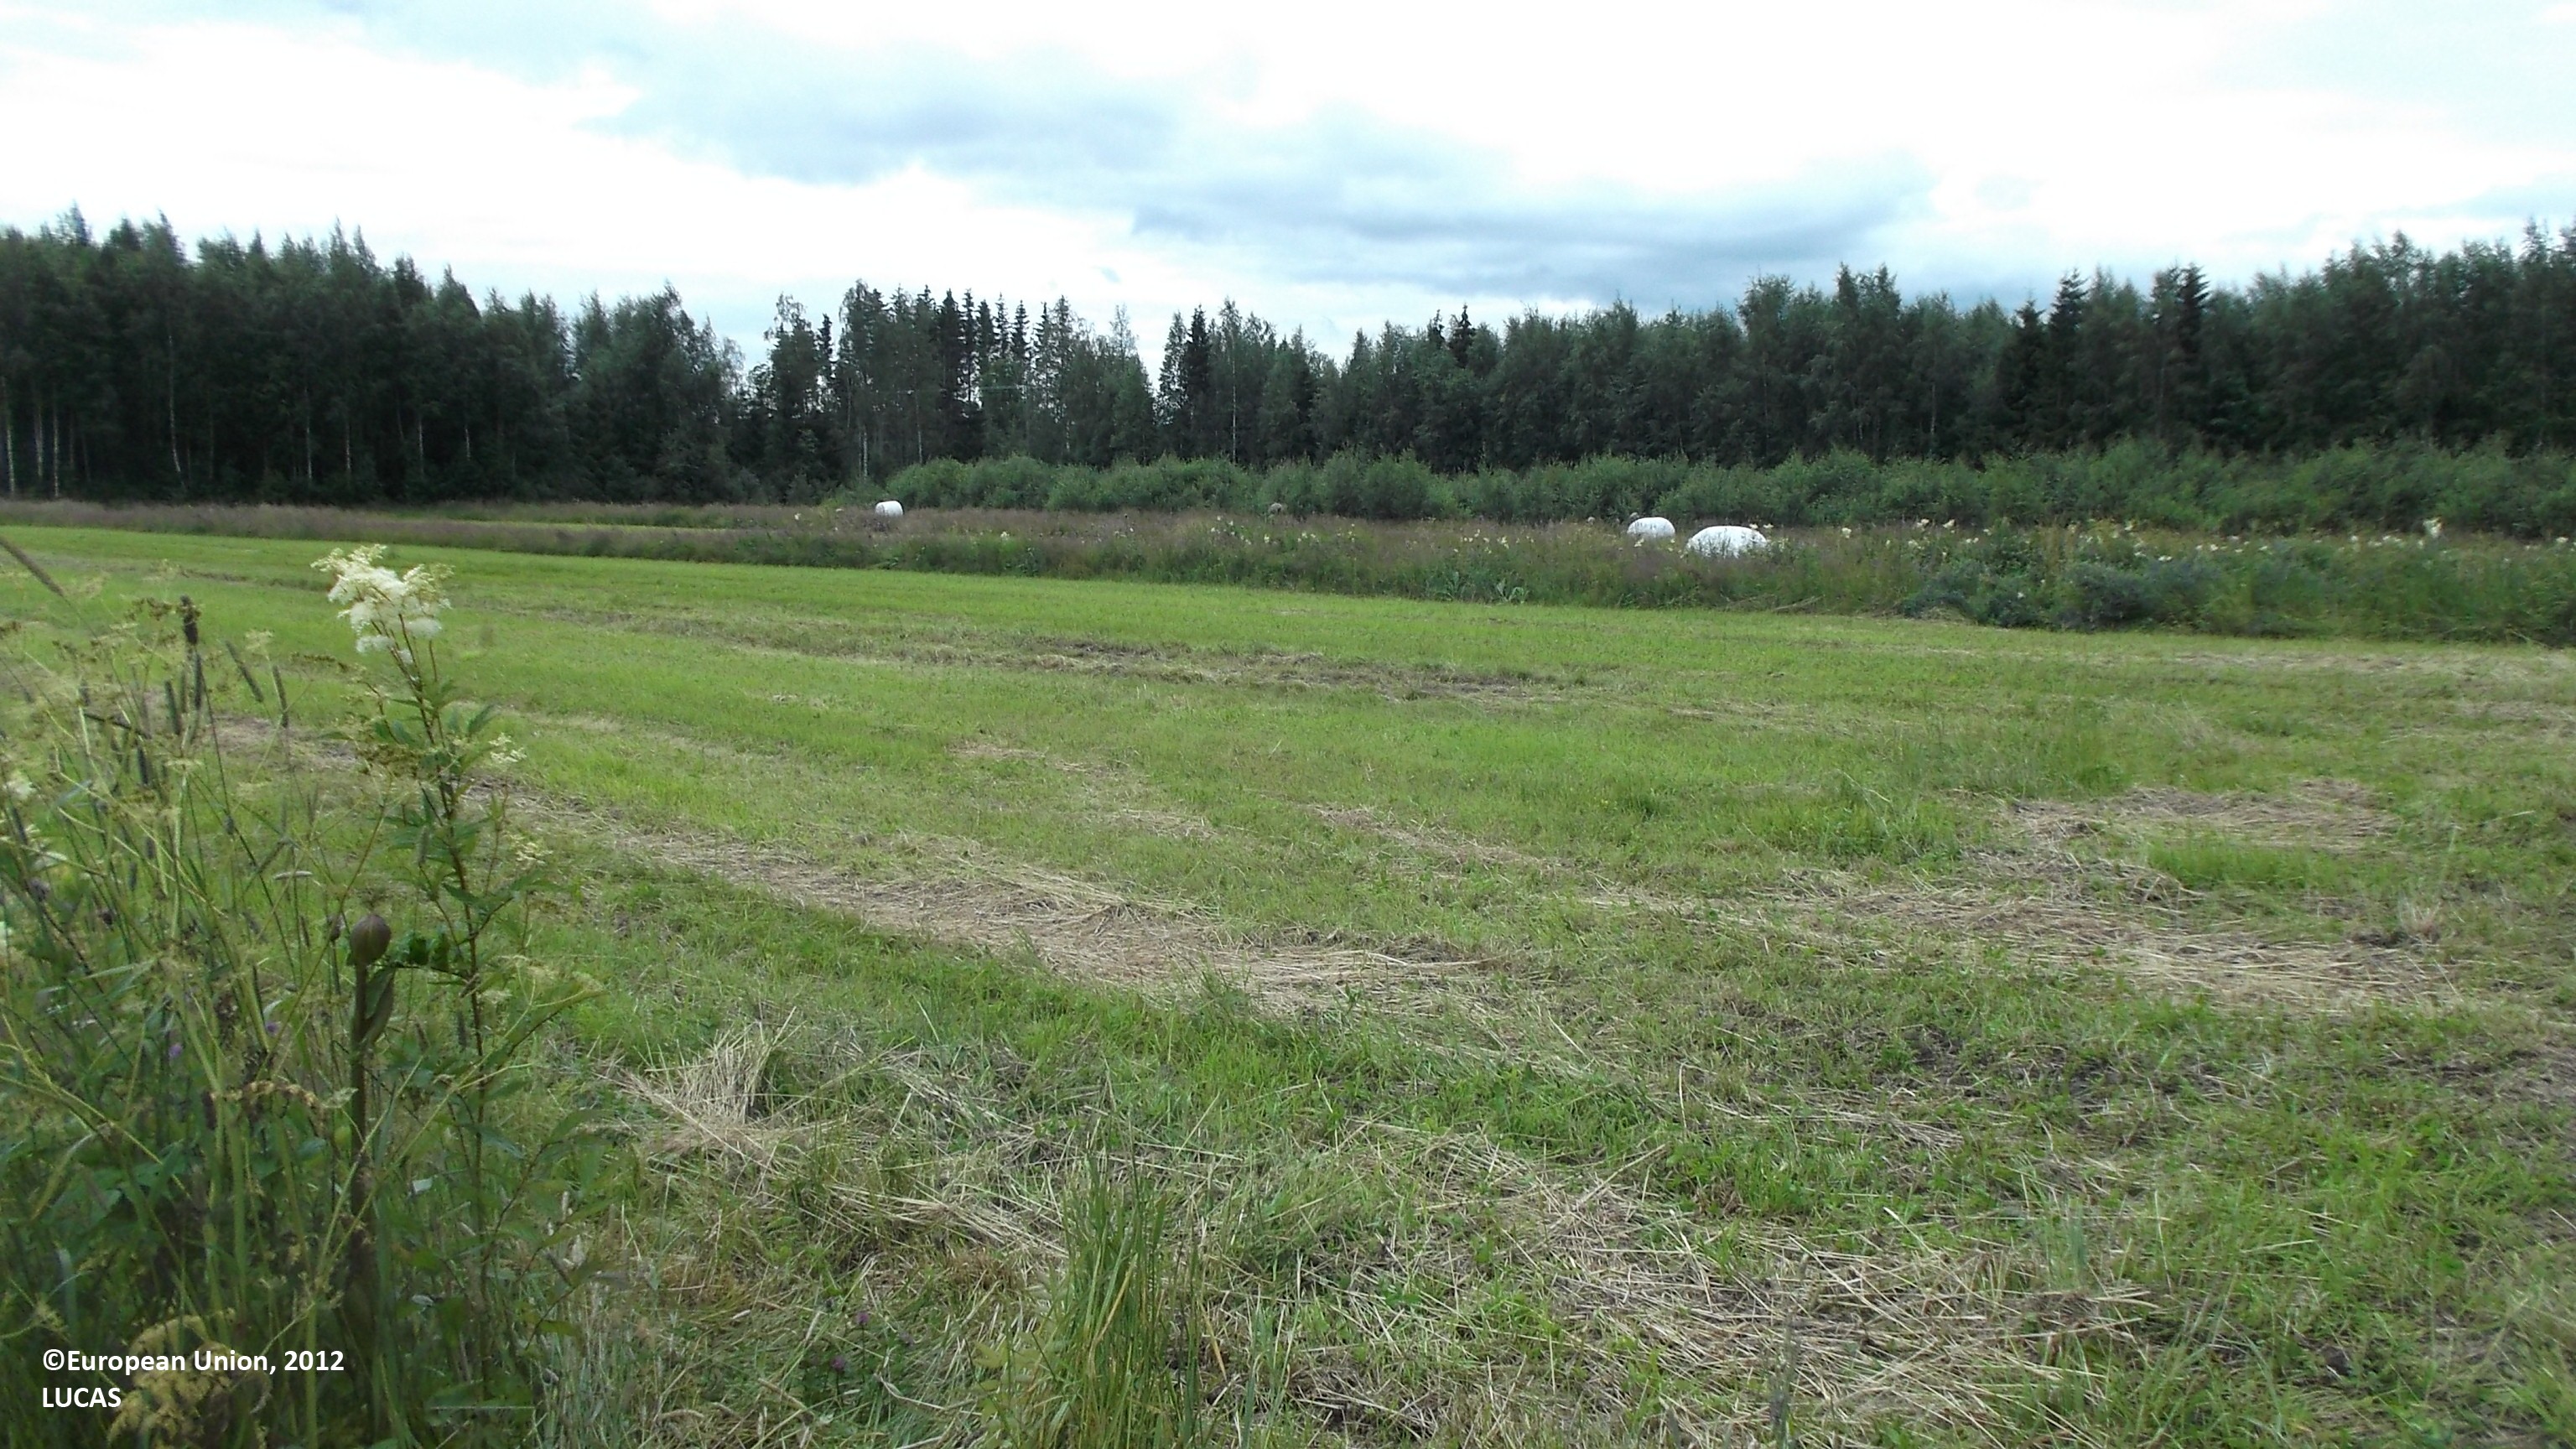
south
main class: Cropland
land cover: Temporary grasslands
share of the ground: > 75 %
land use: Agriculture (excluding fallow land and kitchen gardens)
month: July
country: FI
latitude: 63.7018
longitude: 23.1437
